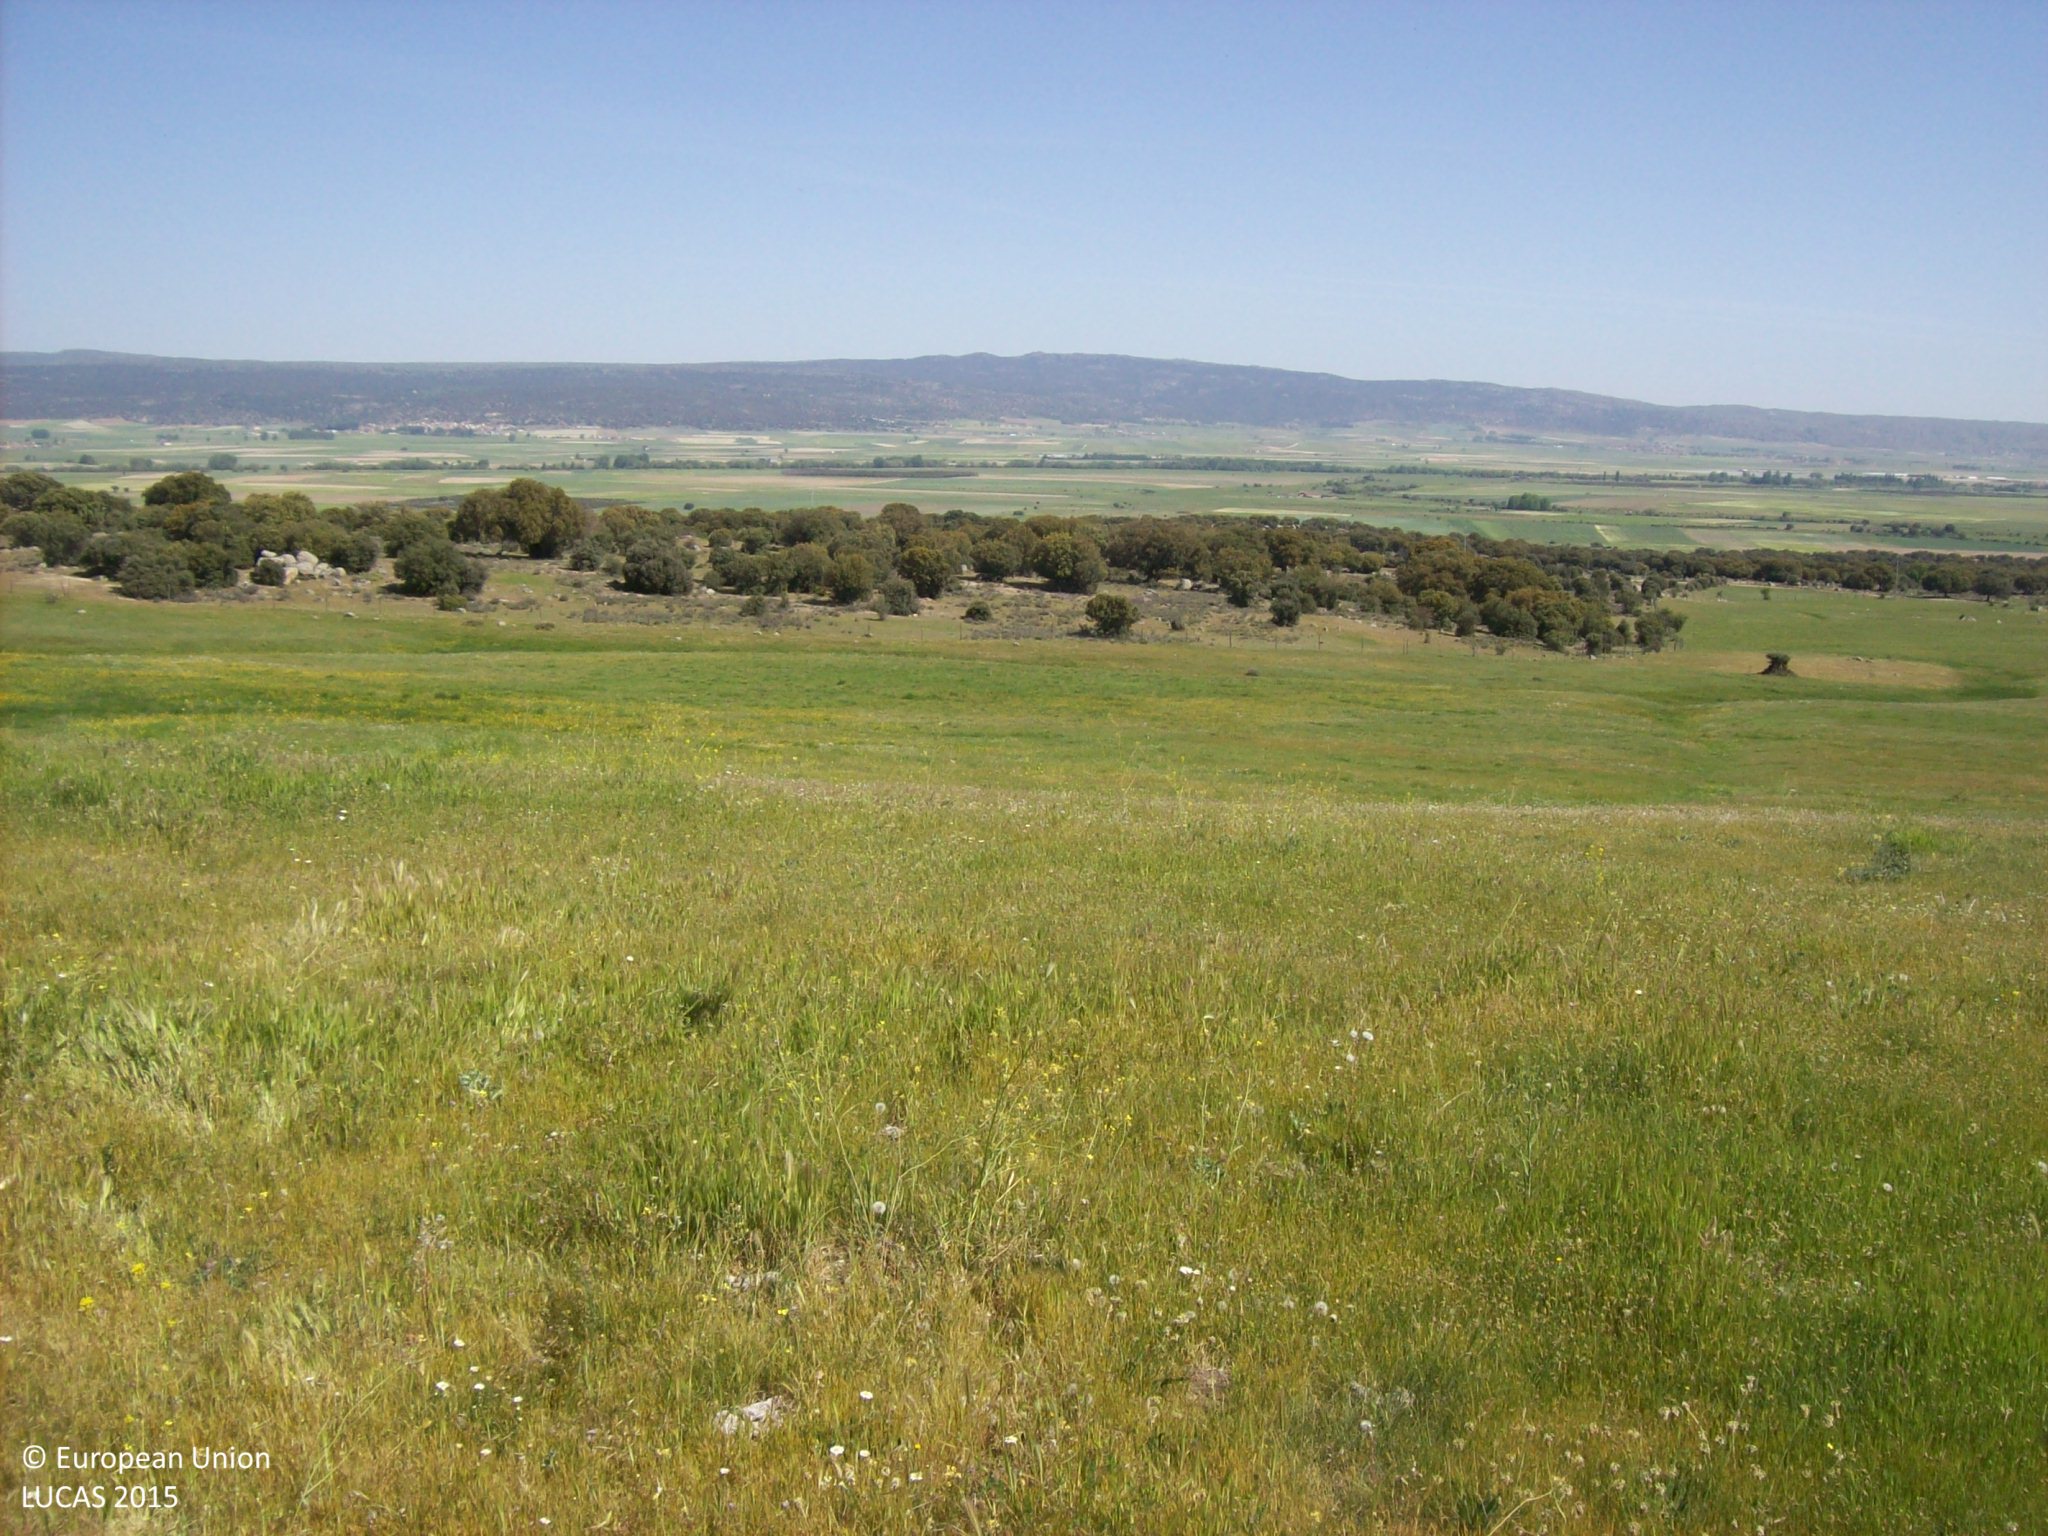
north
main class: Grassland
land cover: Grassland without tree/shrub cover
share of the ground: > 75 %
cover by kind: herbaceous plants 95 %, shrubs 5 %
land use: Agriculture (excluding fallow land and kitchen gardens)
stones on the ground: < 10 %
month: May
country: ES
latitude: 40.5399
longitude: -4.8743
